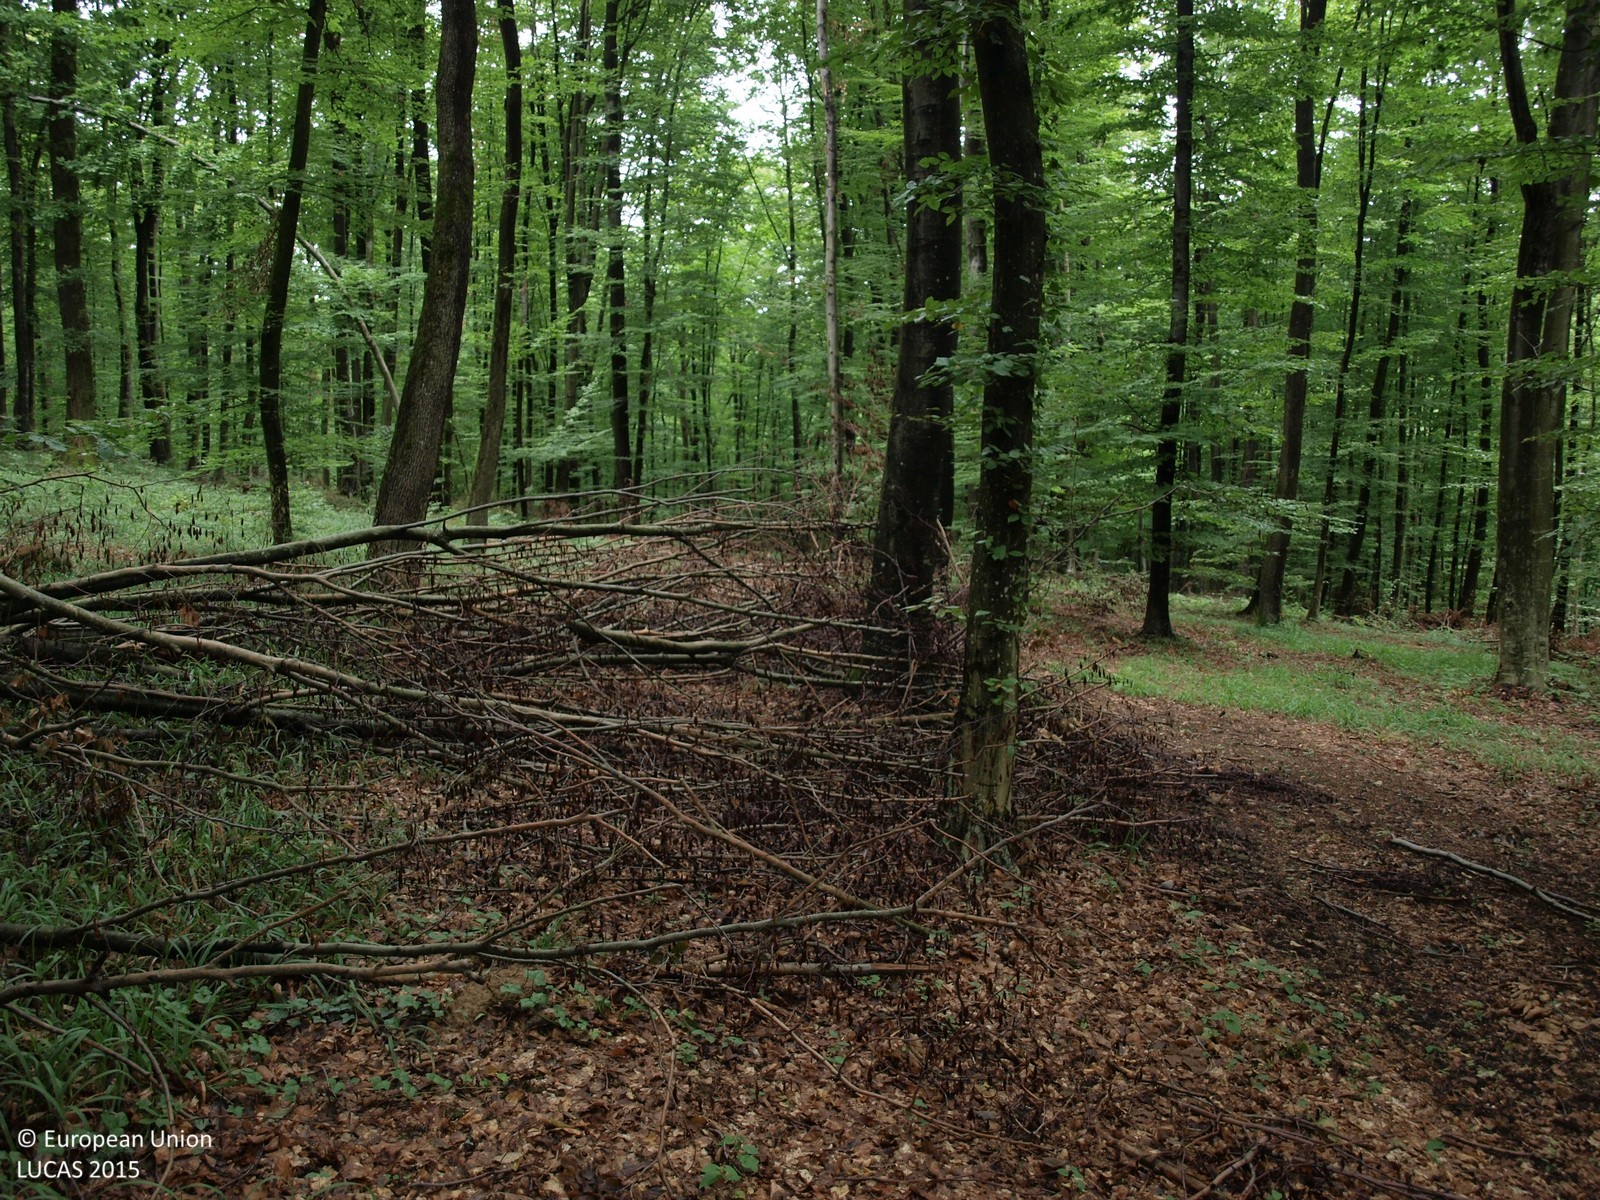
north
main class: Woodland
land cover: Broadleaved woodland
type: beech forest
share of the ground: > 75 %
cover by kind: broadleaved forest trees 100 %
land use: Forestry
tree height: > 5 m
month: July
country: HR
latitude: 46.0559
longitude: 16.3199
